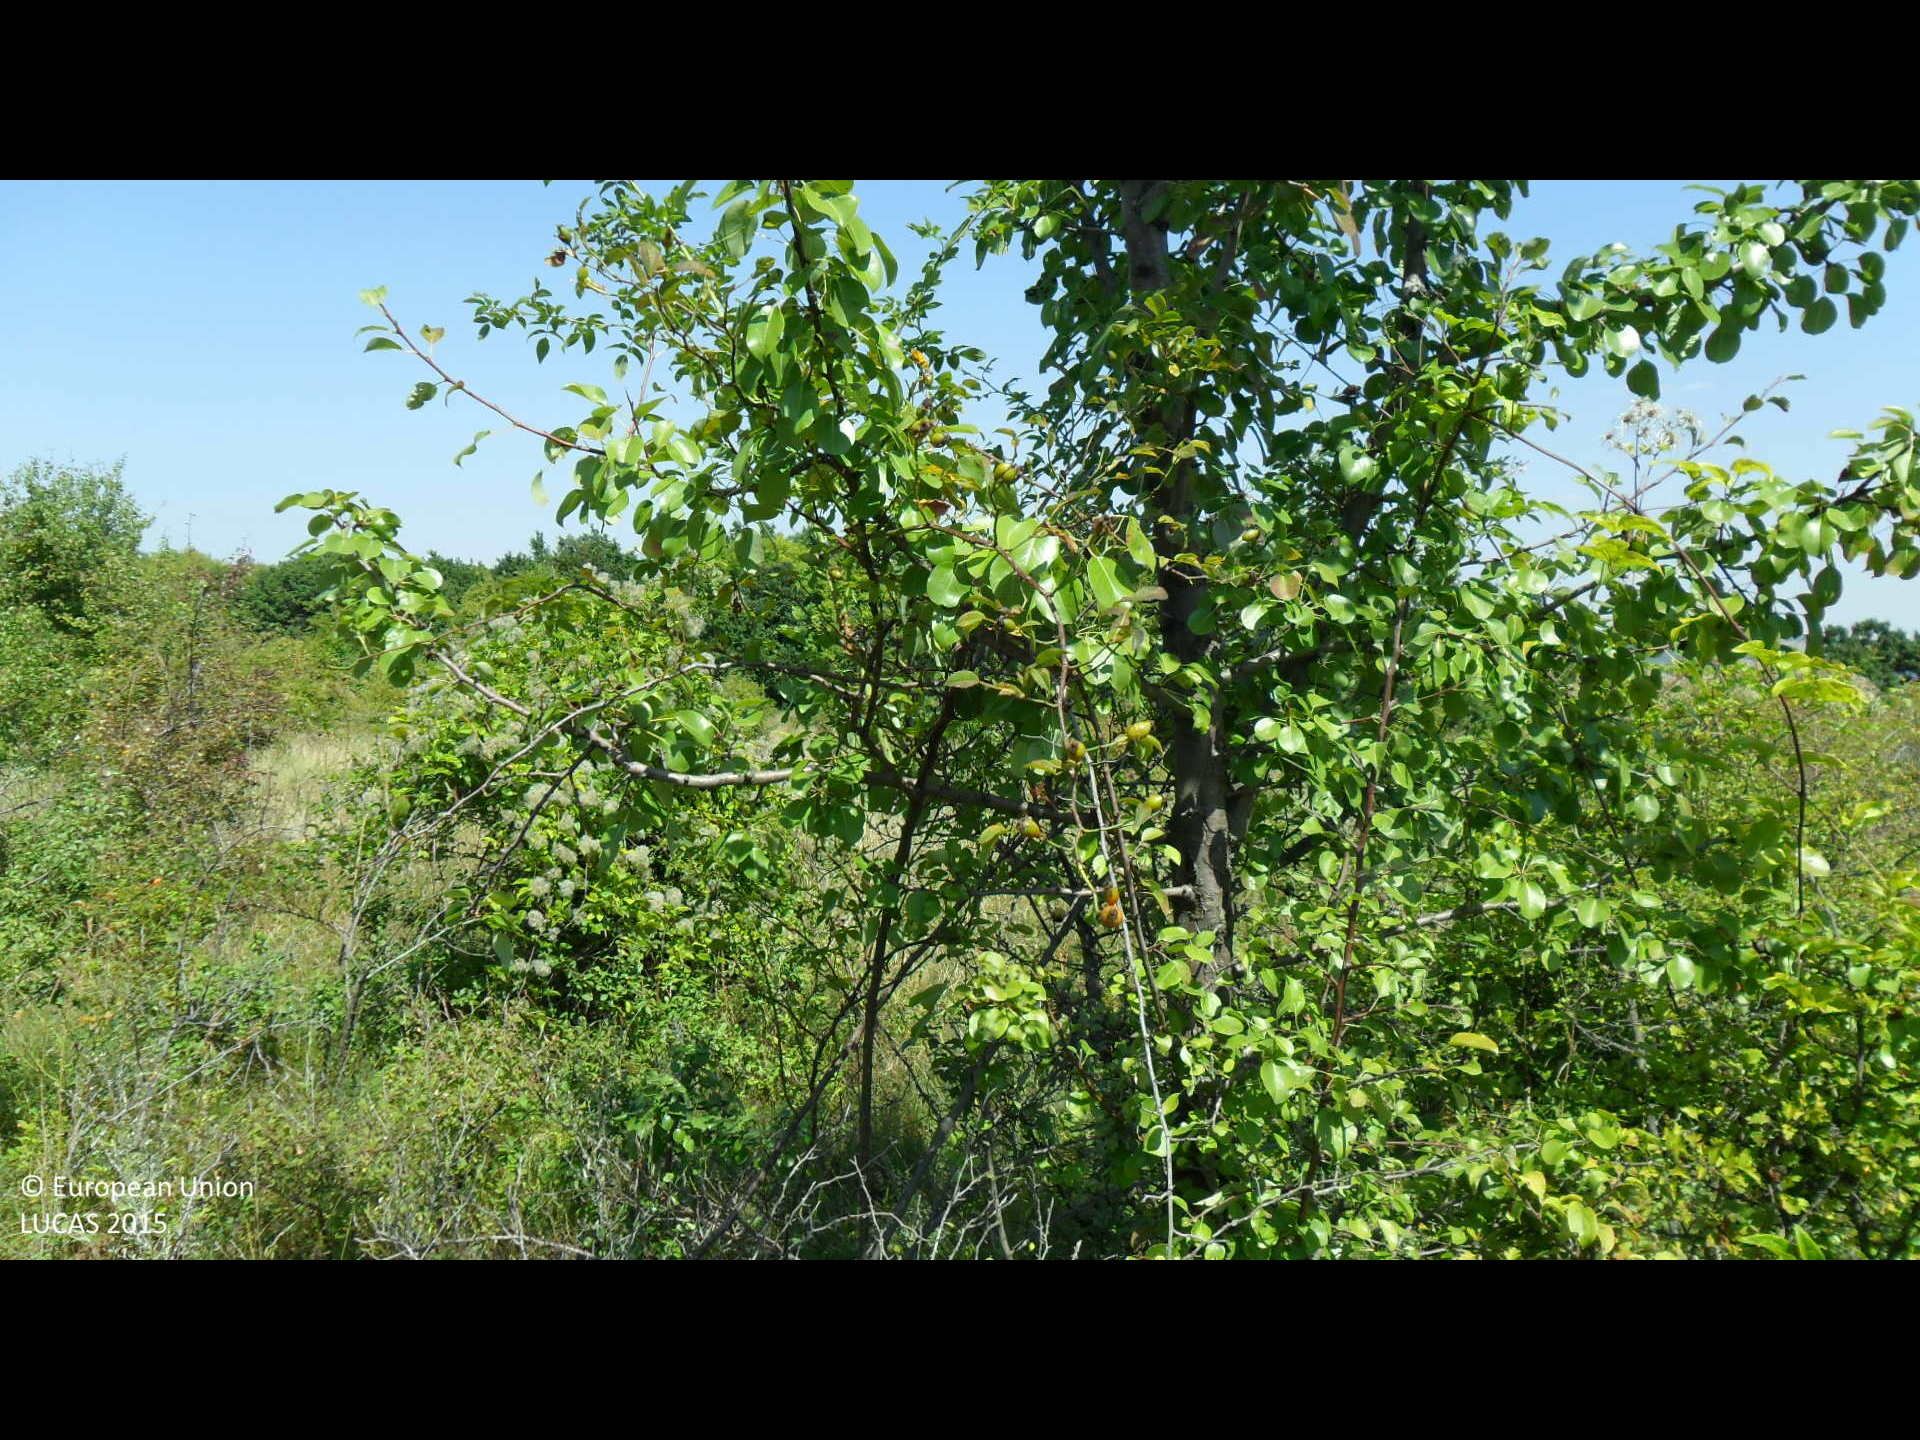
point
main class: Shrubland
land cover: Shrubland without tree cover
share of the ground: > 75 %
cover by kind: shrubs 75 %, herbaceous plants 25 %
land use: Semi-natural and natural areas not in use
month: August
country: BG
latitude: 43.4630
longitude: 26.2526
